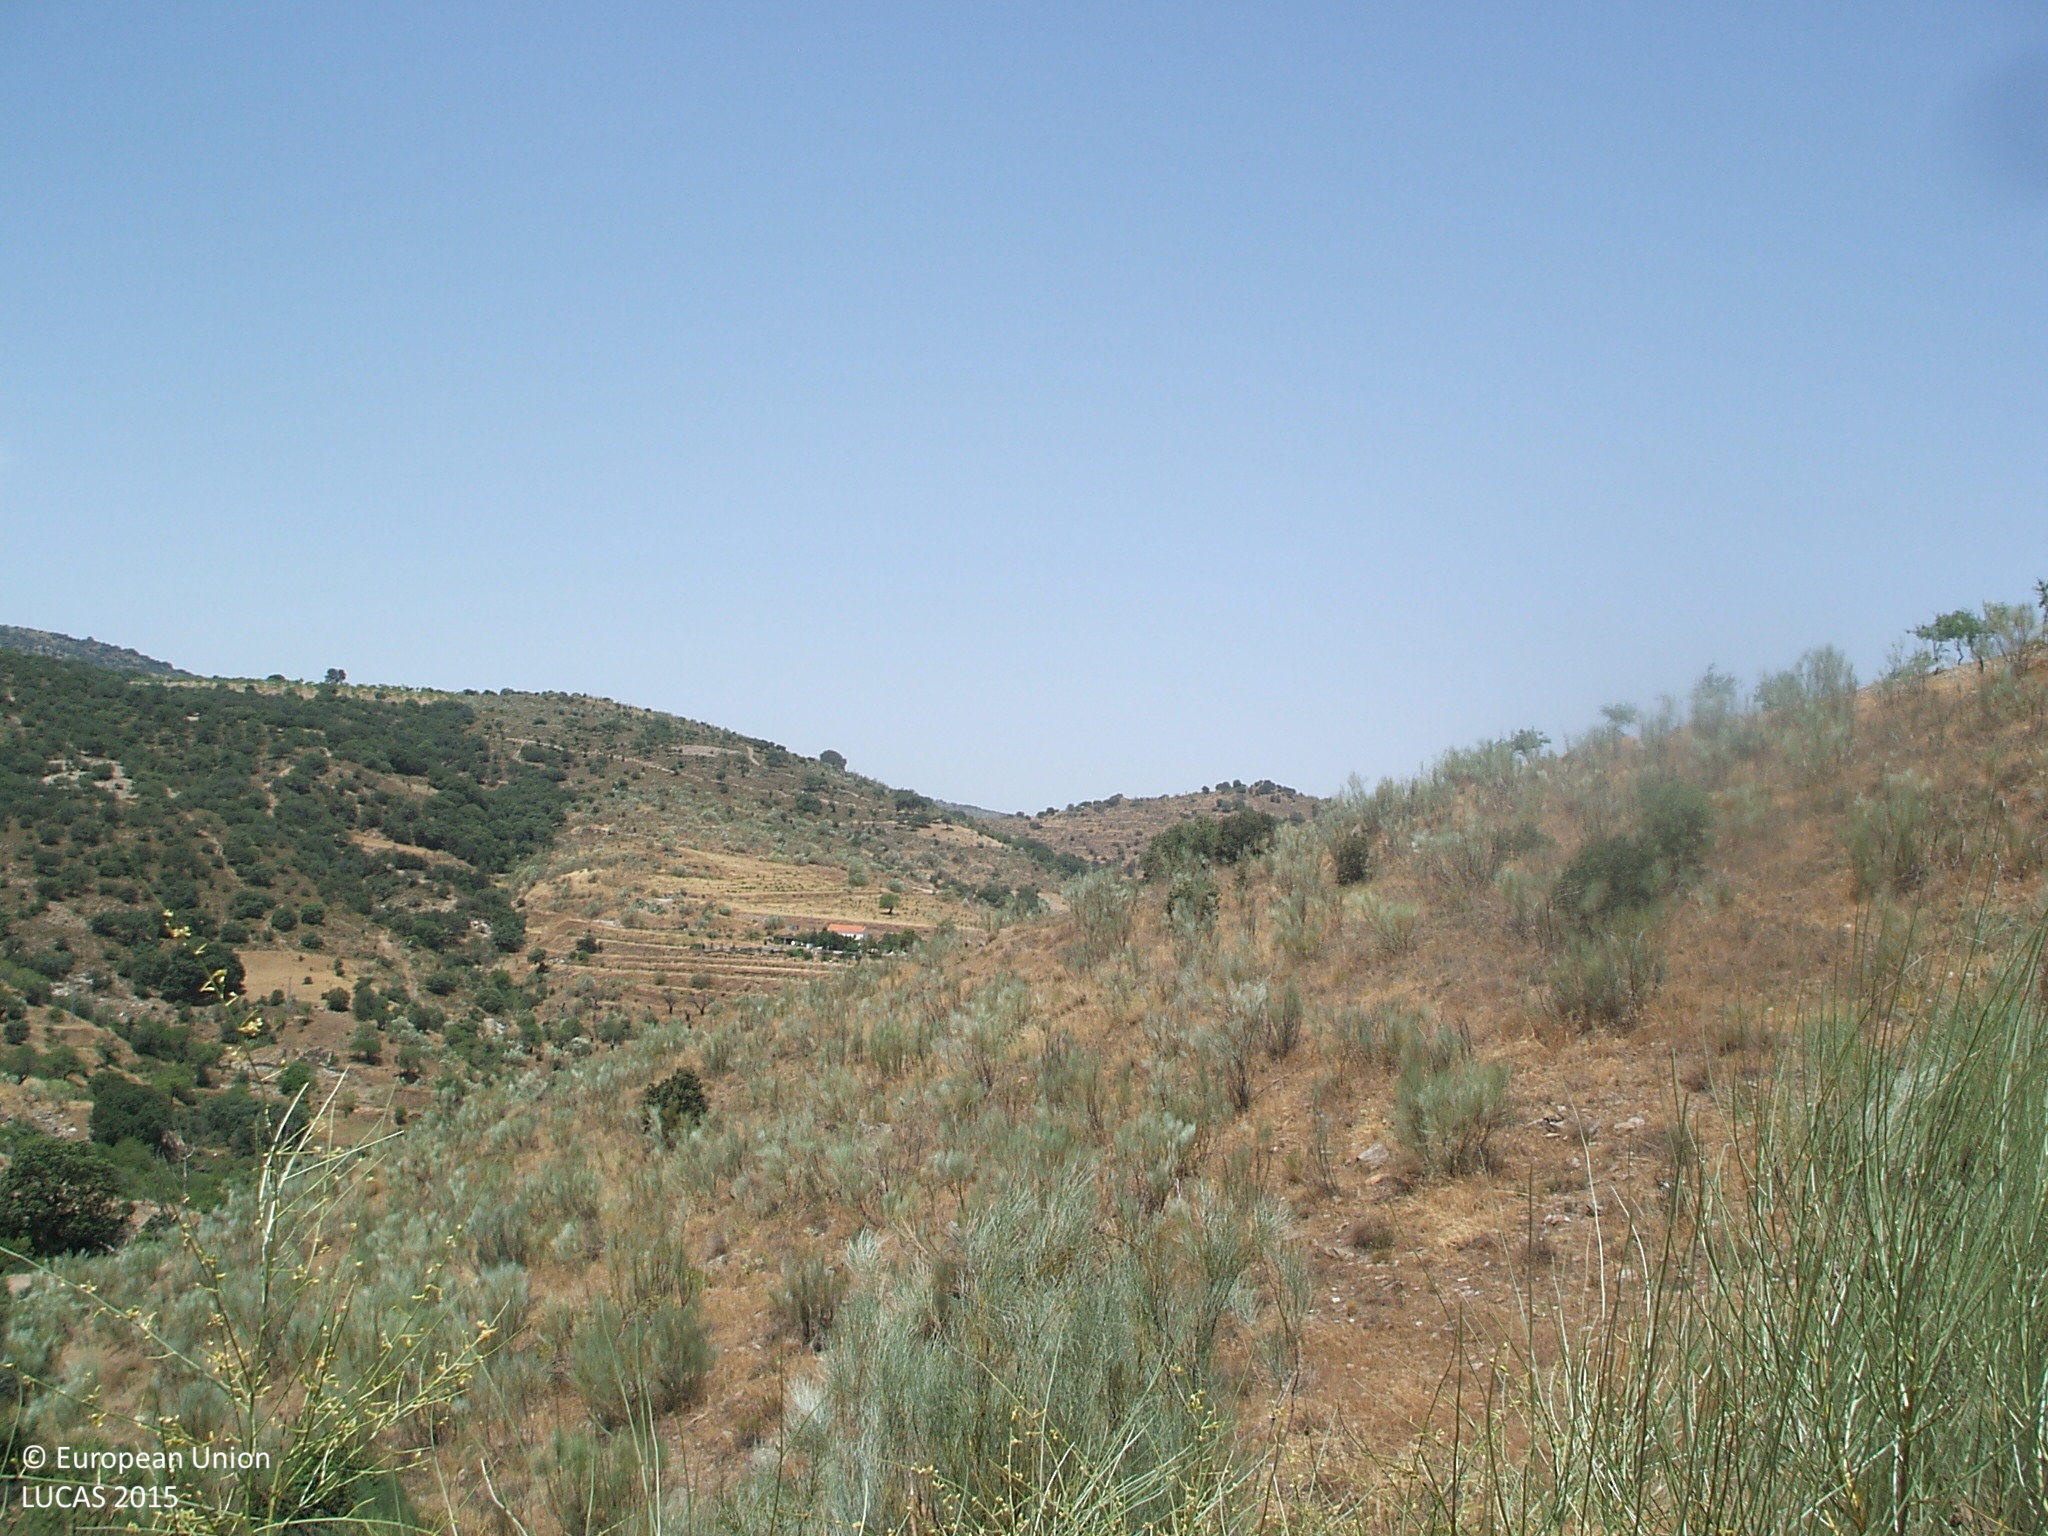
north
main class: Shrubland
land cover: Shrubland without tree cover
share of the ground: 50 - 75 %
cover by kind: shrubs 70 %, herbaceous plants 30 %
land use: Semi-natural and natural areas not in use
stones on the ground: > 50 %
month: July
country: ES
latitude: 37.2539
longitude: -2.3262
